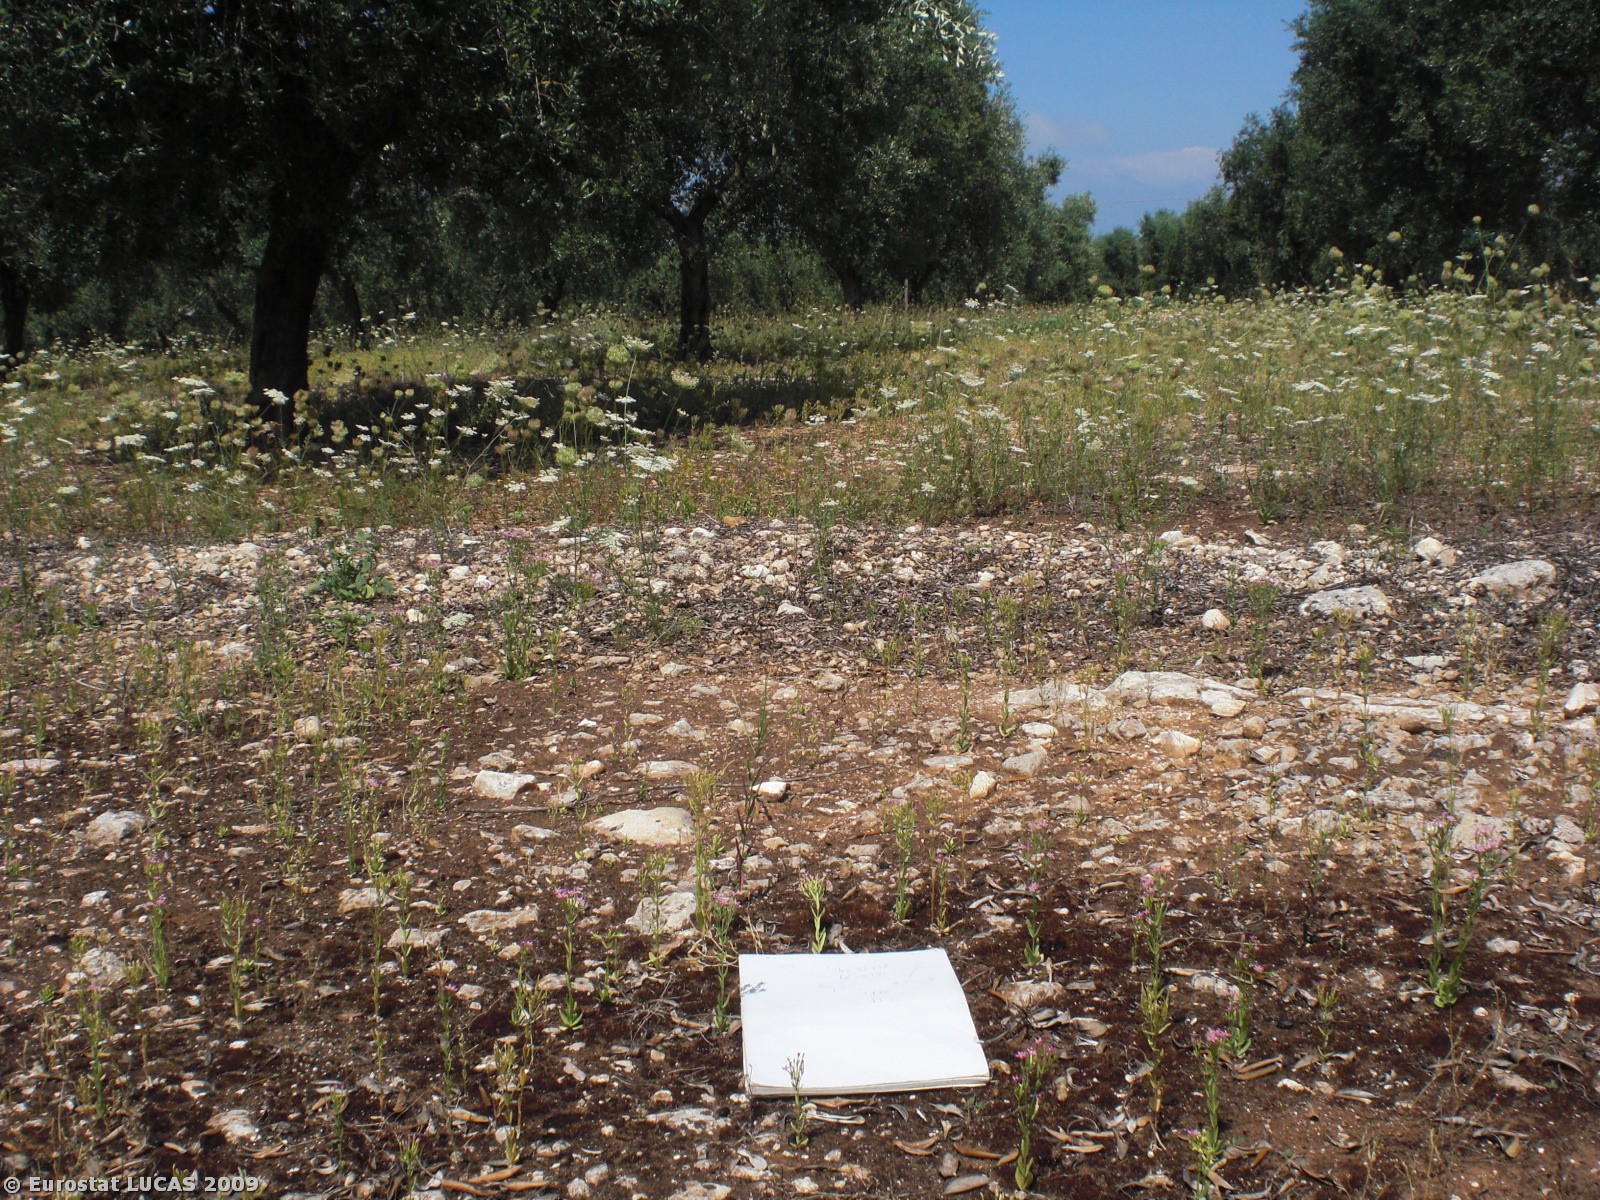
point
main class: Cropland
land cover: Olive groves
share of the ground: > 75 %
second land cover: Spontaneously vegetated surfaces
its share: 50 - 75 %
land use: Agriculture (excluding fallow land and kitchen gardens)
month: July
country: IT
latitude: 40.4371
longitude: 18.1456
